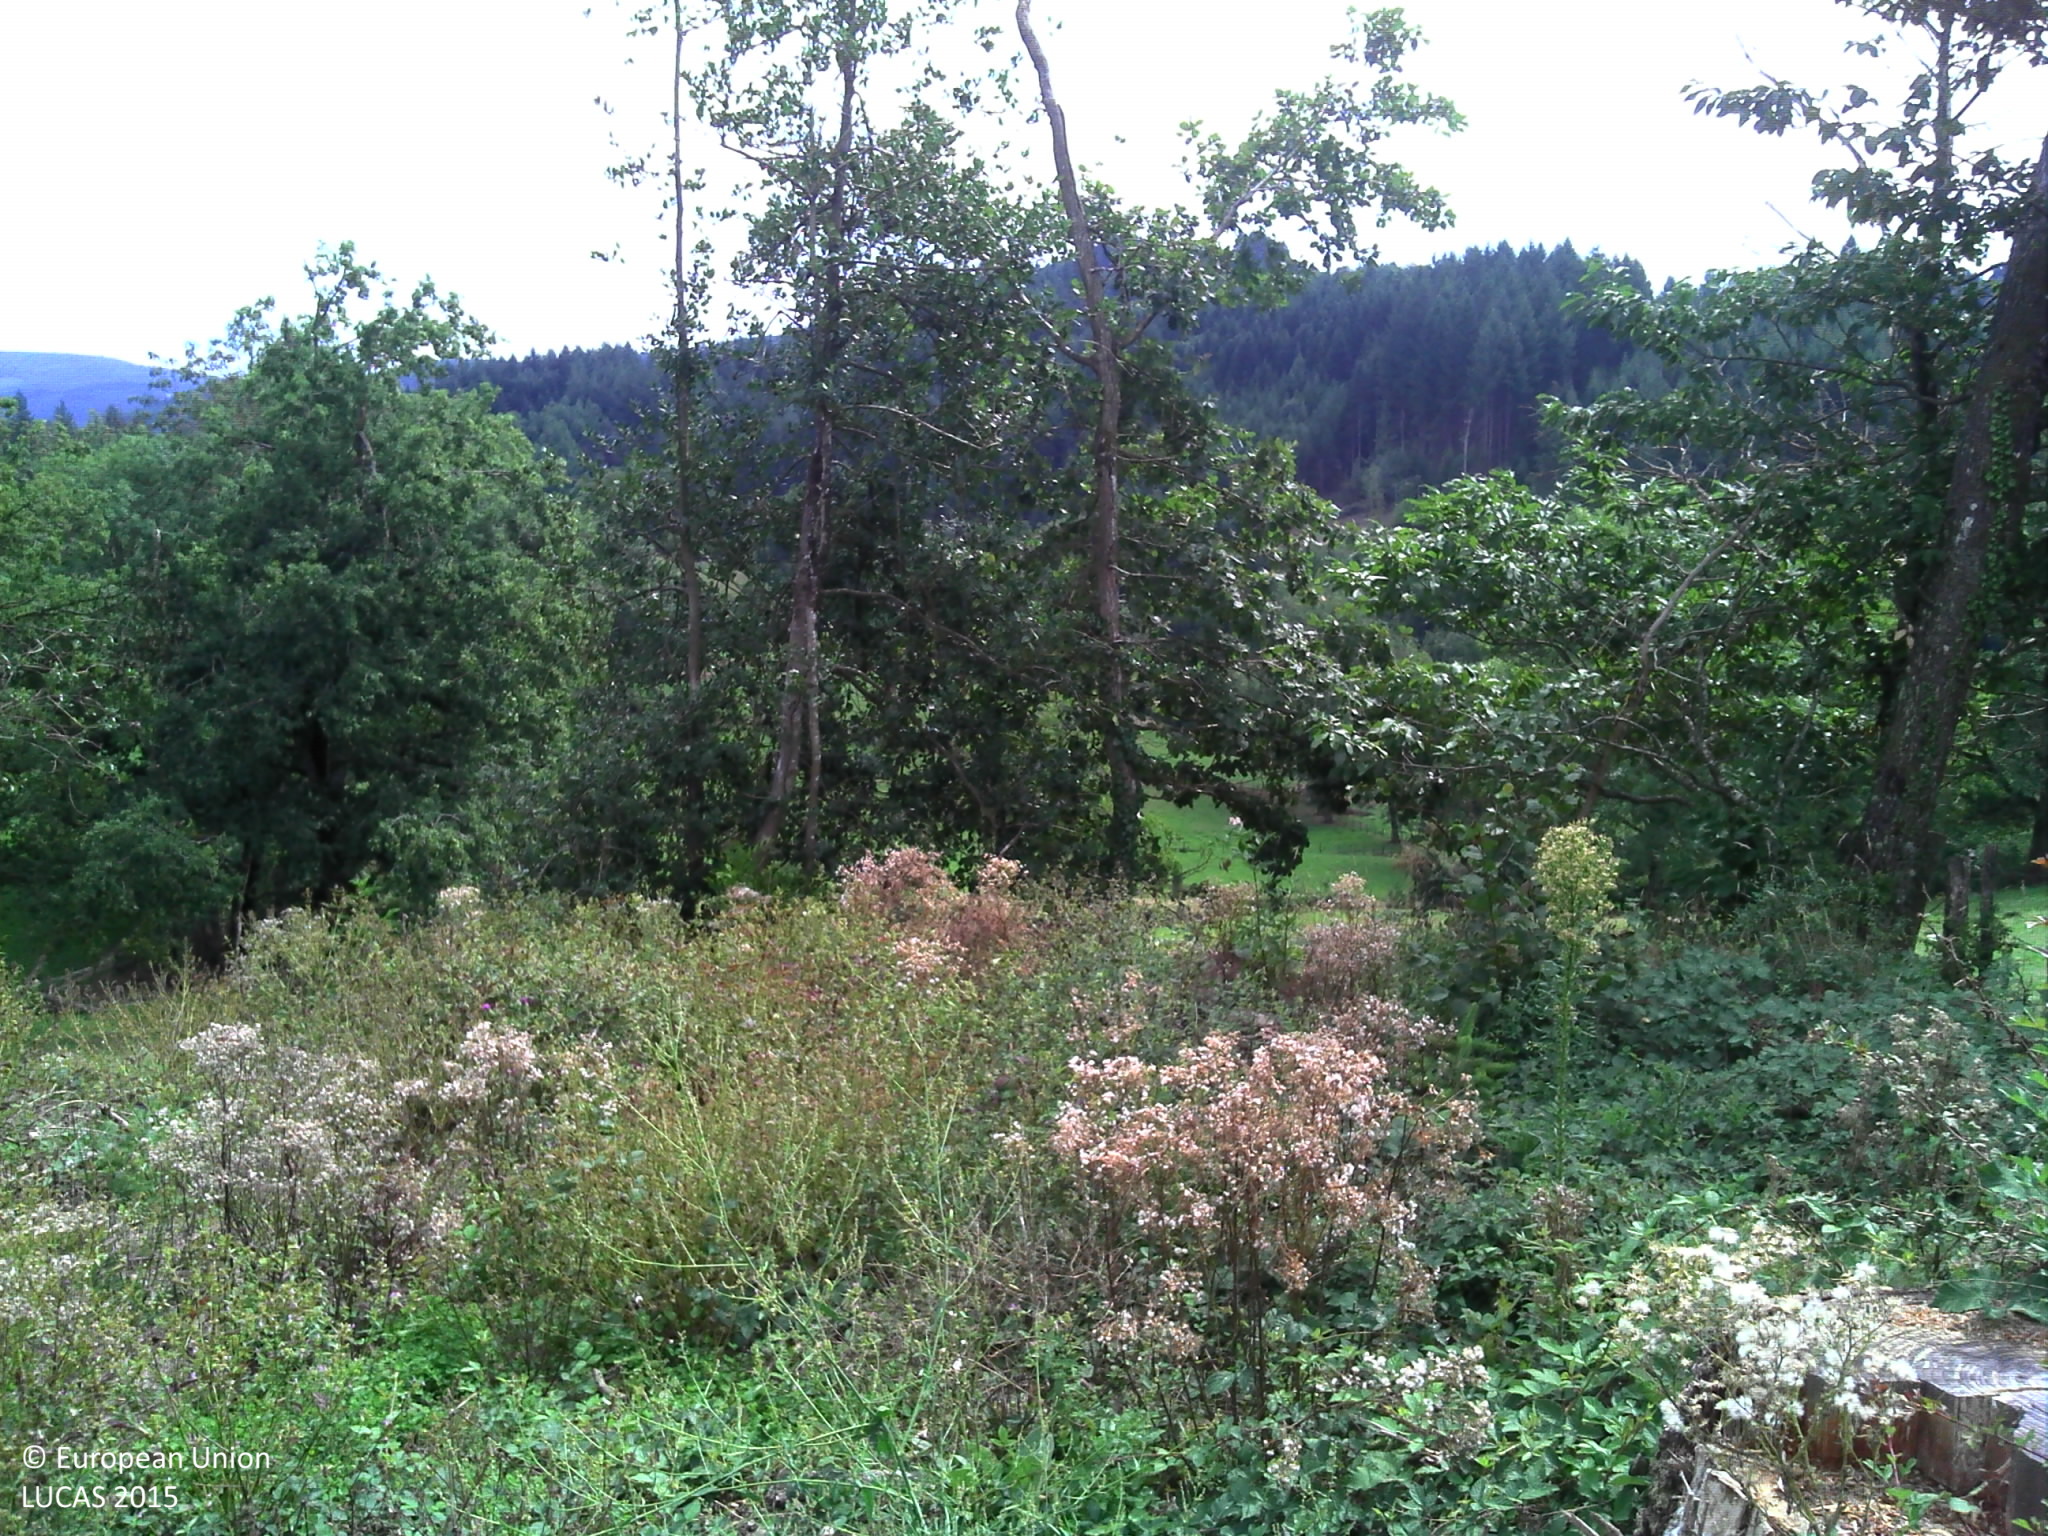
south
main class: Shrubland
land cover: Shrubland without tree cover
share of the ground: > 75 %
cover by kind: shrubs 60 %, herbaceous plants 30 %, consolidated bare surface 10 %
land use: Forestry
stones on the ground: 25 - 50 %
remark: Clear cut
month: August
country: FR
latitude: 46.2413
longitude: 4.4122
